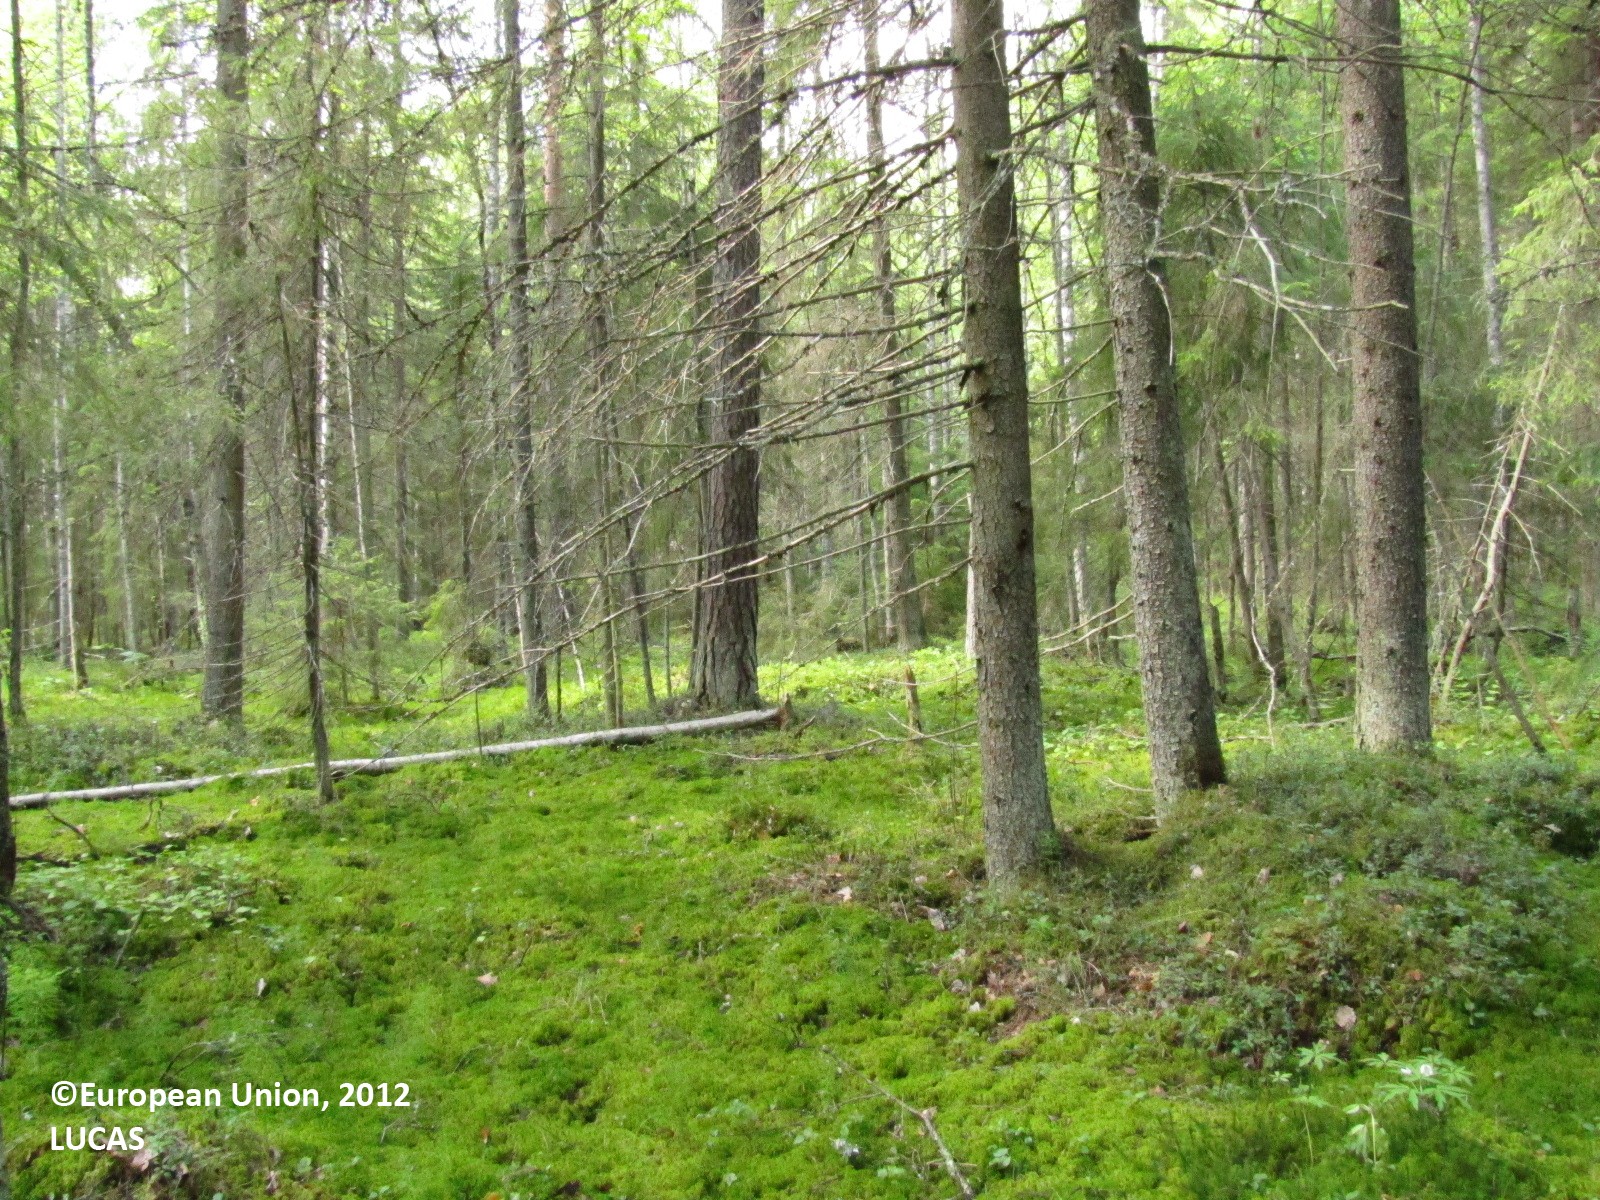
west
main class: Woodland
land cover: Spruce dominated coniferous woodland
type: boreal forest
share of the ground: > 75 %
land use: Forestry
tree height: > 5 m
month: June
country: FI
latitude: 61.6474
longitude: 23.1535
